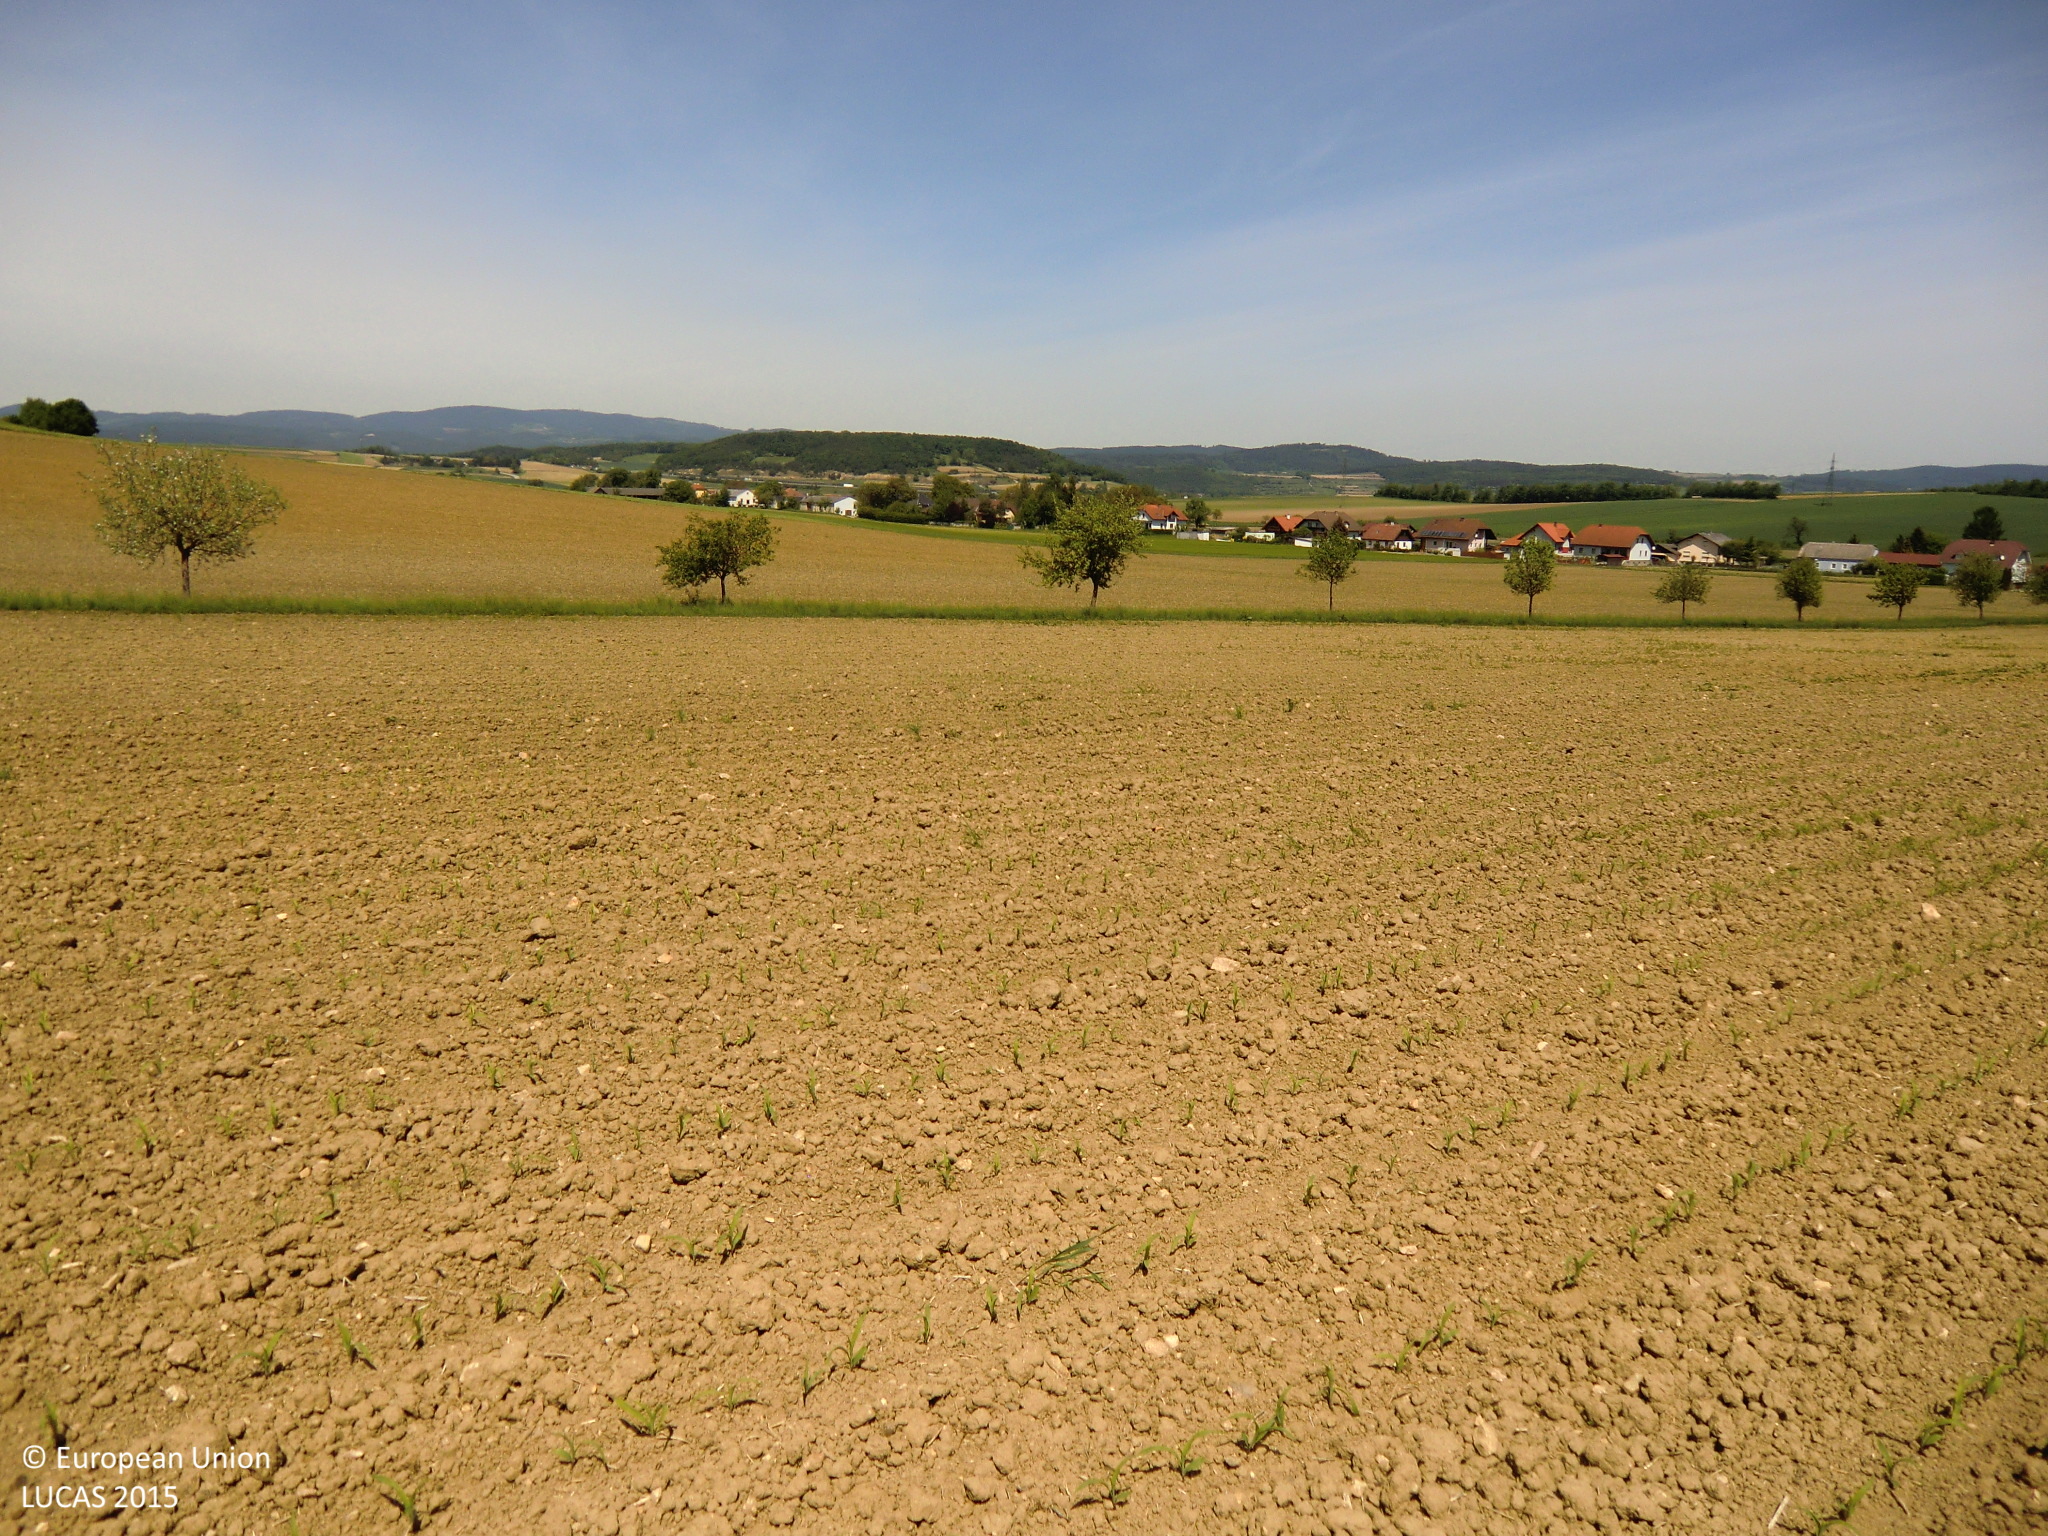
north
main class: Cropland
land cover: Maize
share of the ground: 25 - 50 %
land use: Agriculture (excluding fallow land and kitchen gardens)
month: May
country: AT
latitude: 48.1829
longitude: 15.3685
